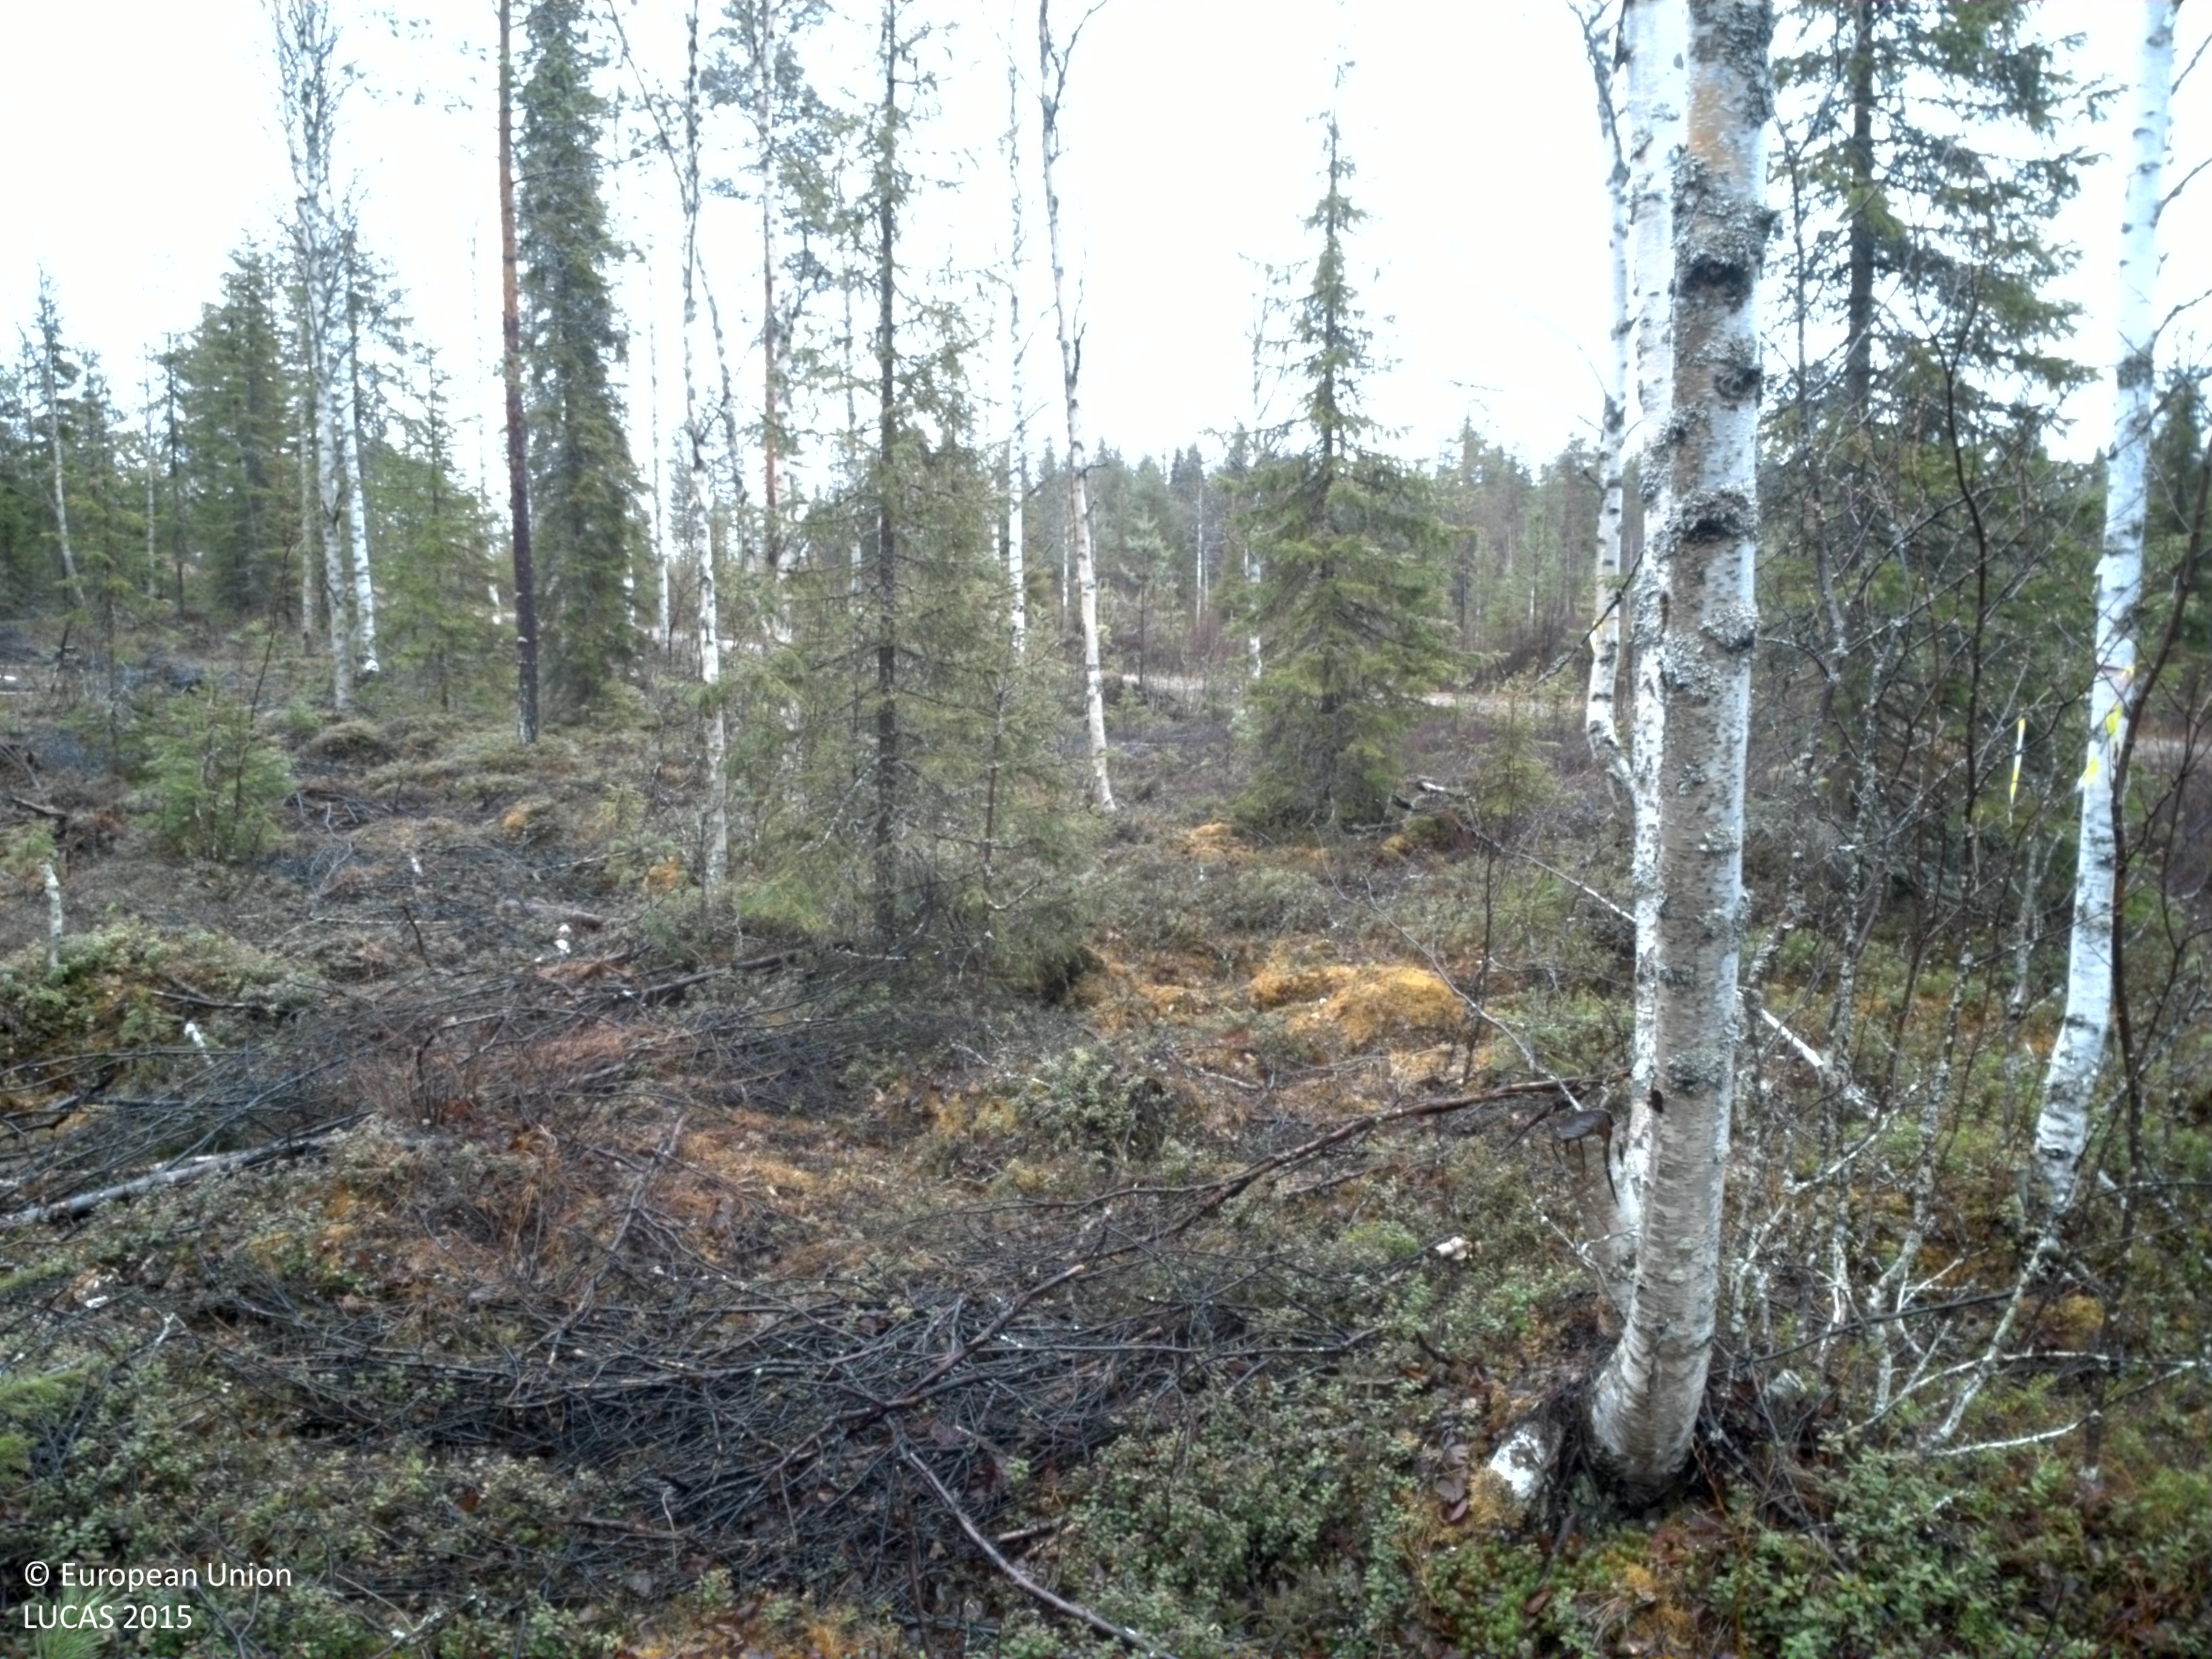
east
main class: Woodland
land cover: Spruce dominated mixed woodland
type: boreal forest
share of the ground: 50 - 75 %
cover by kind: coniferous forest trees 45 %, shrubs 25 %, broadleaved forest trees 15 %, lichens and mosses 15 %
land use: Forestry
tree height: > 5 m
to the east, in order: Spruce dominated mixed woodland; Ditches and canals; Groves; Tracks; Pine dominated mixed woodland; Tracks; Groves; Ditches and canals; Pine dominated mixed woodland; Other coniferous woodland; Other mixed woodland
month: May
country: SE
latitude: 66.5262
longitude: 23.2311
